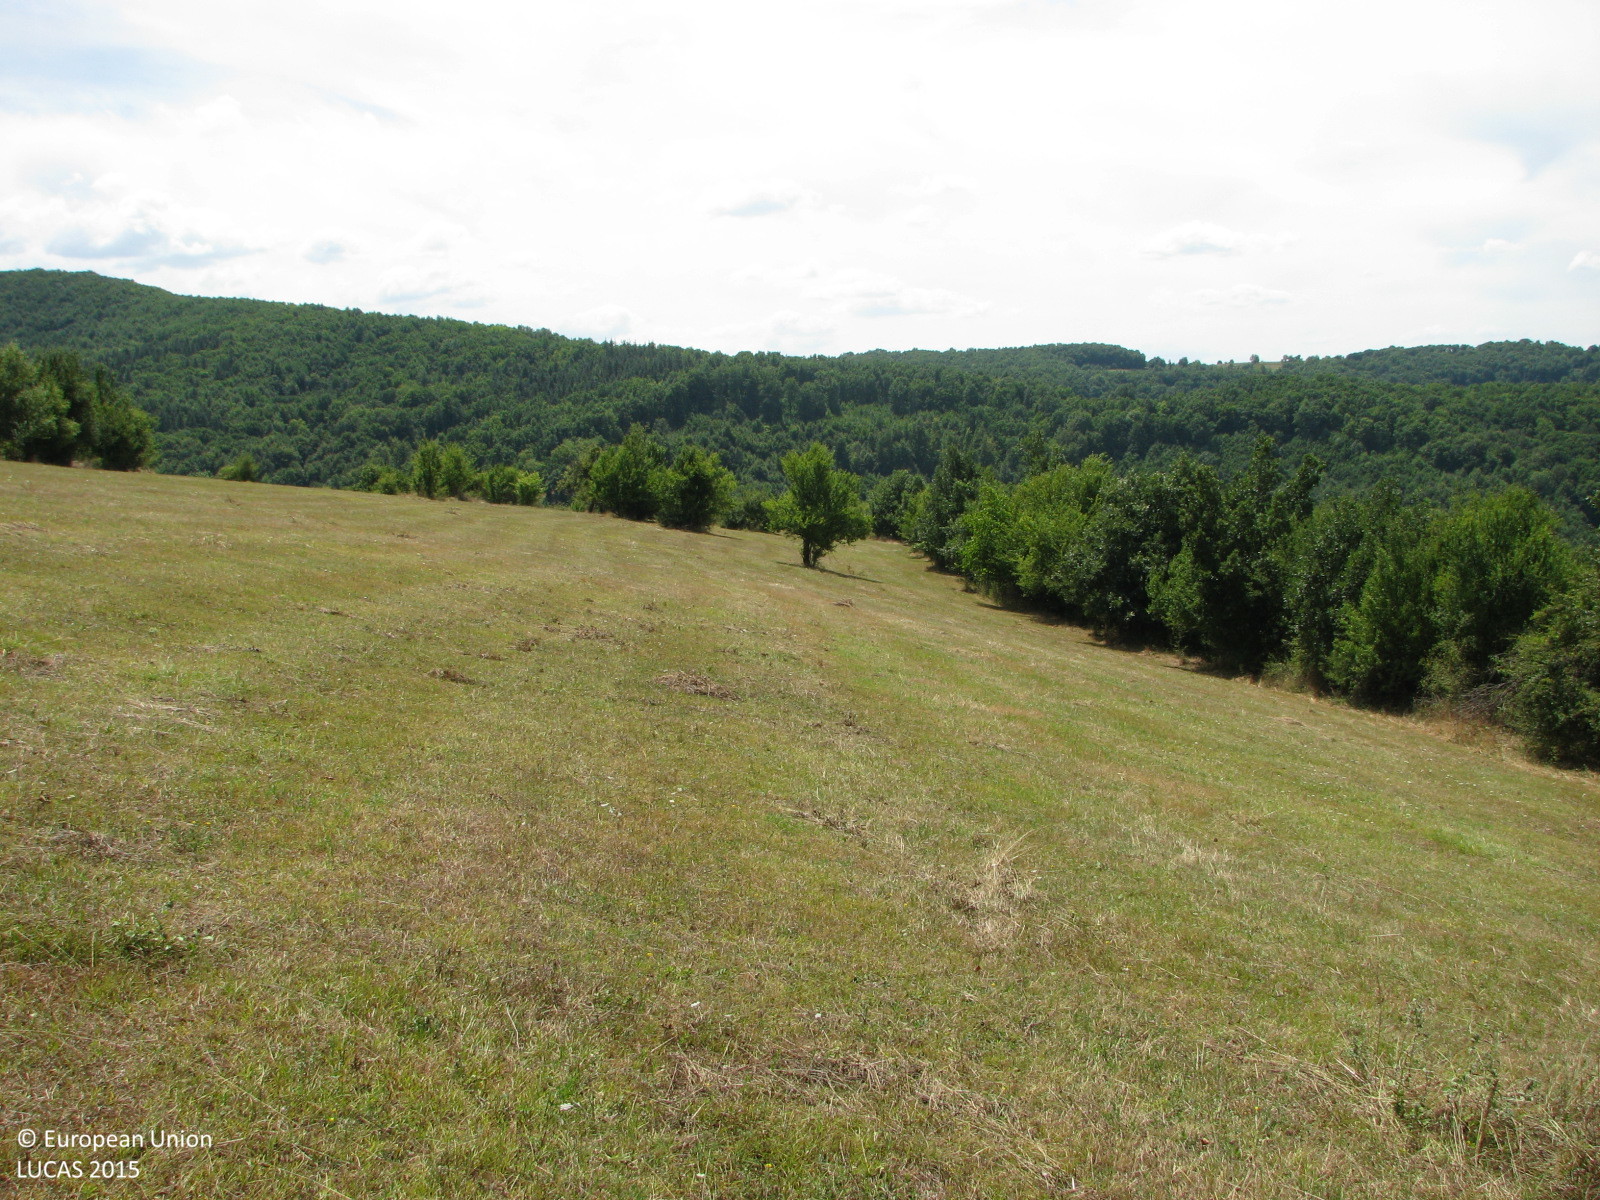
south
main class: Grassland
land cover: Grassland without tree/shrub cover
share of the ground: > 75 %
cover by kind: herbaceous plants 100 %
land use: Agriculture (excluding fallow land and kitchen gardens)
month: August
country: BG
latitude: 42.9691
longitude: 26.2392
